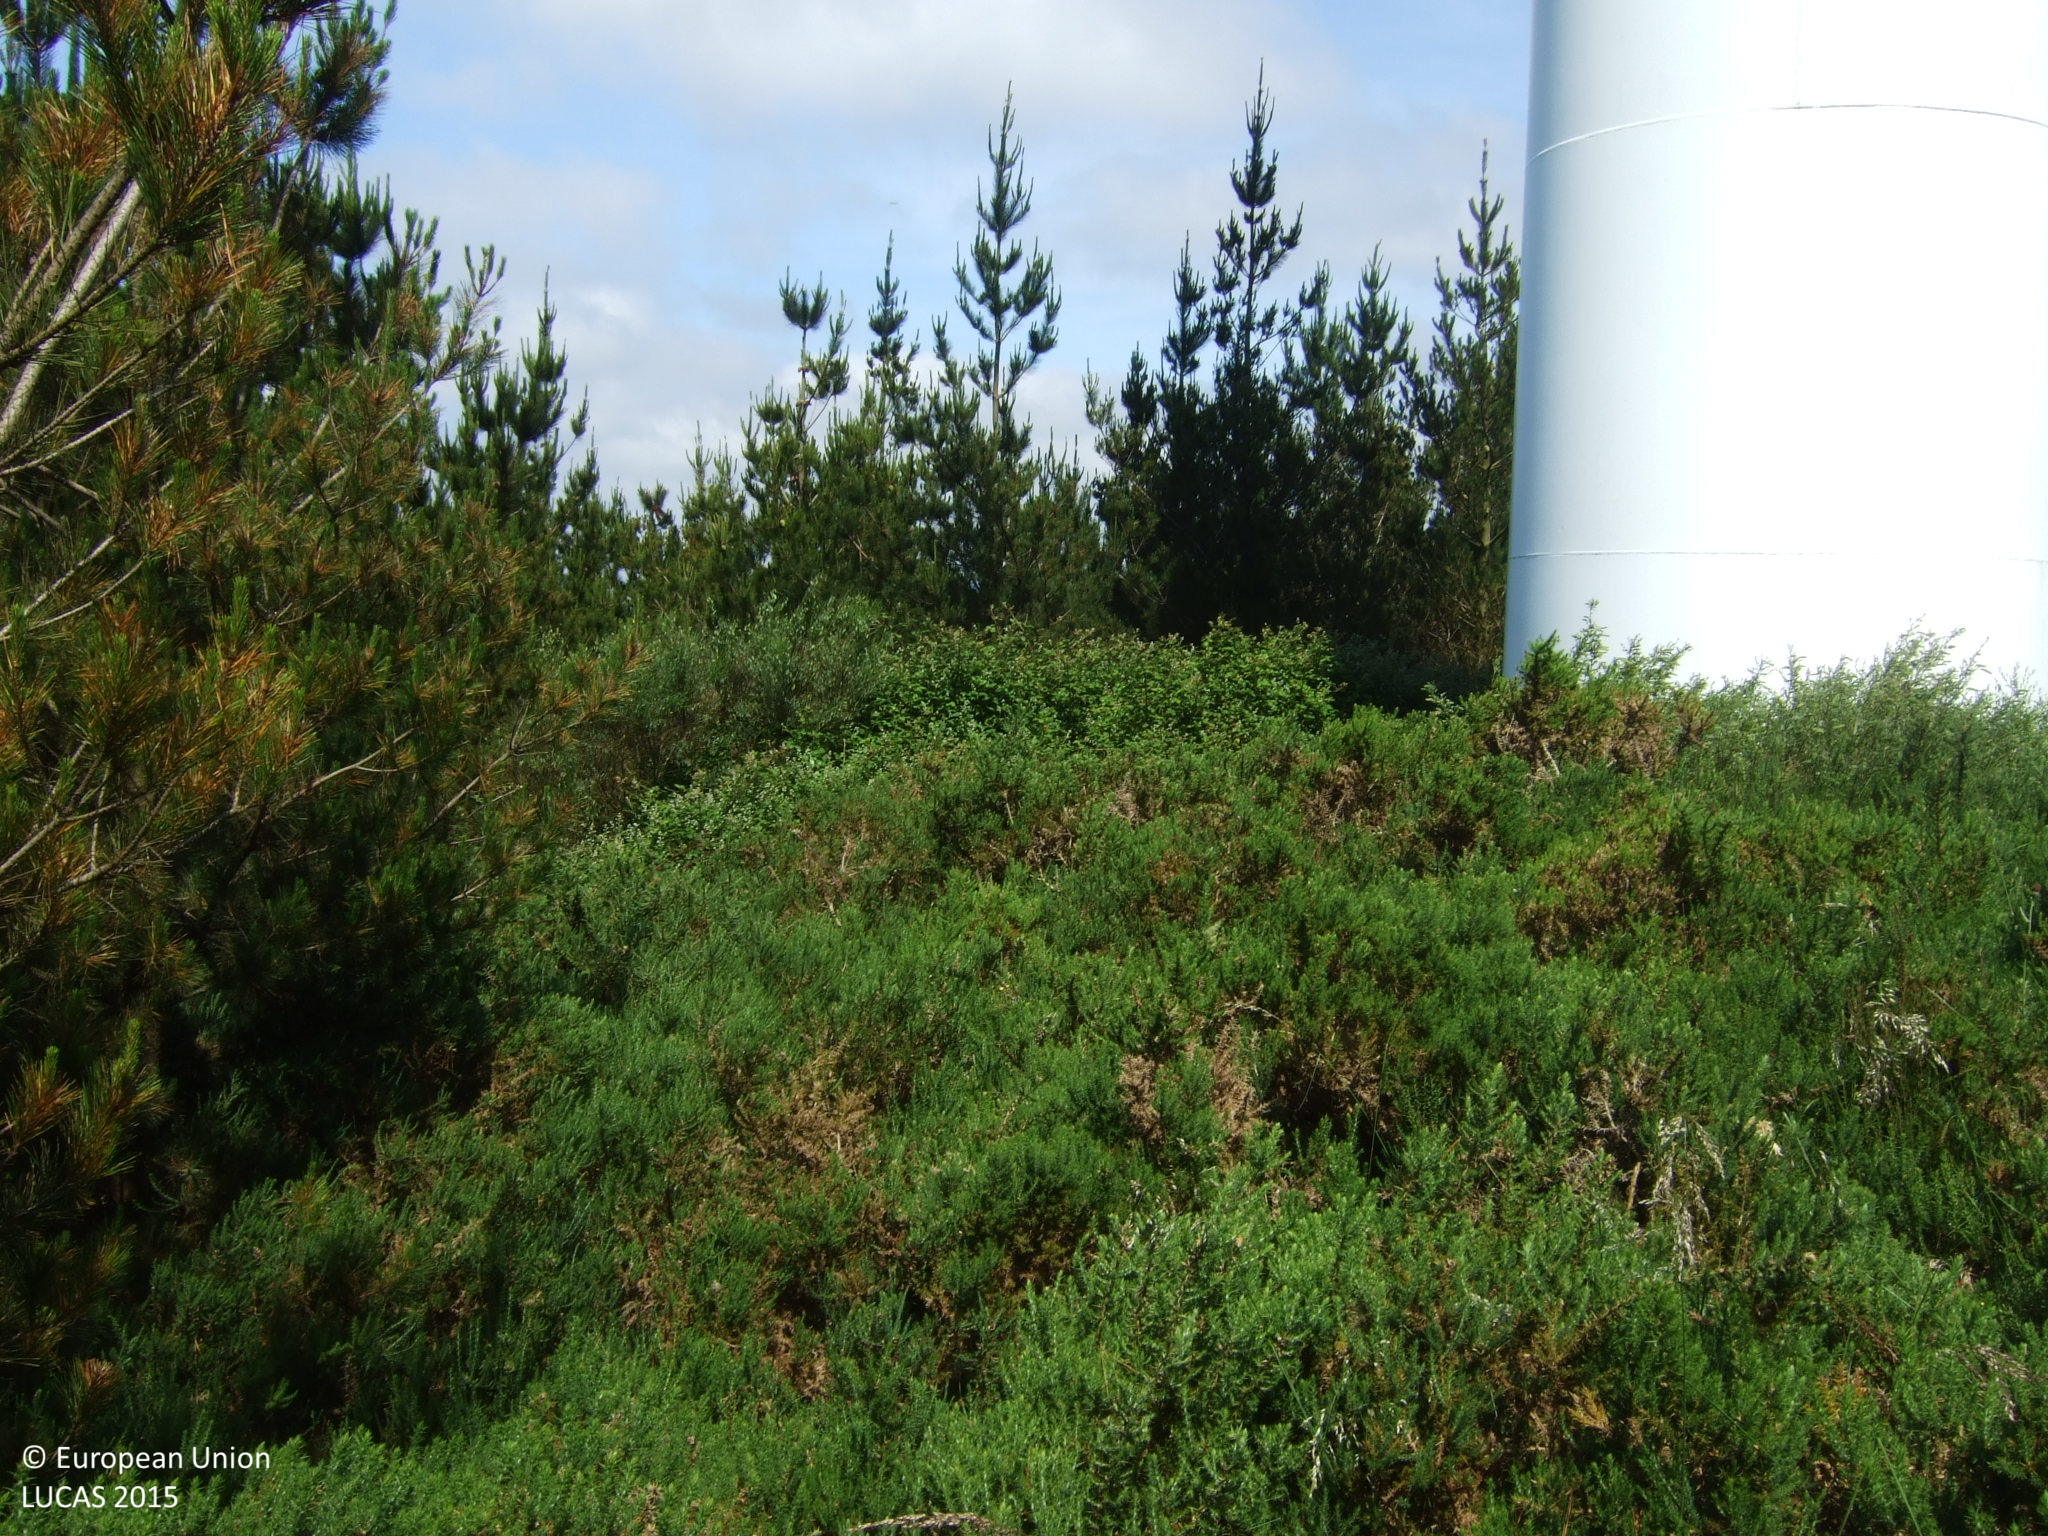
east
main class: Woodland
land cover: Pine dominated coniferous woodland
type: exotic forest
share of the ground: 50 - 75 %
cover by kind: coniferous forest trees 70 %, shrubs 30 %
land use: Forestry
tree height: < 5 m
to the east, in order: Pine dominated coniferous woodland; Artificial constructions in urban areas; Pine dominated coniferous woodland
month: June
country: ES
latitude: 43.4425
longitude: -7.7951
